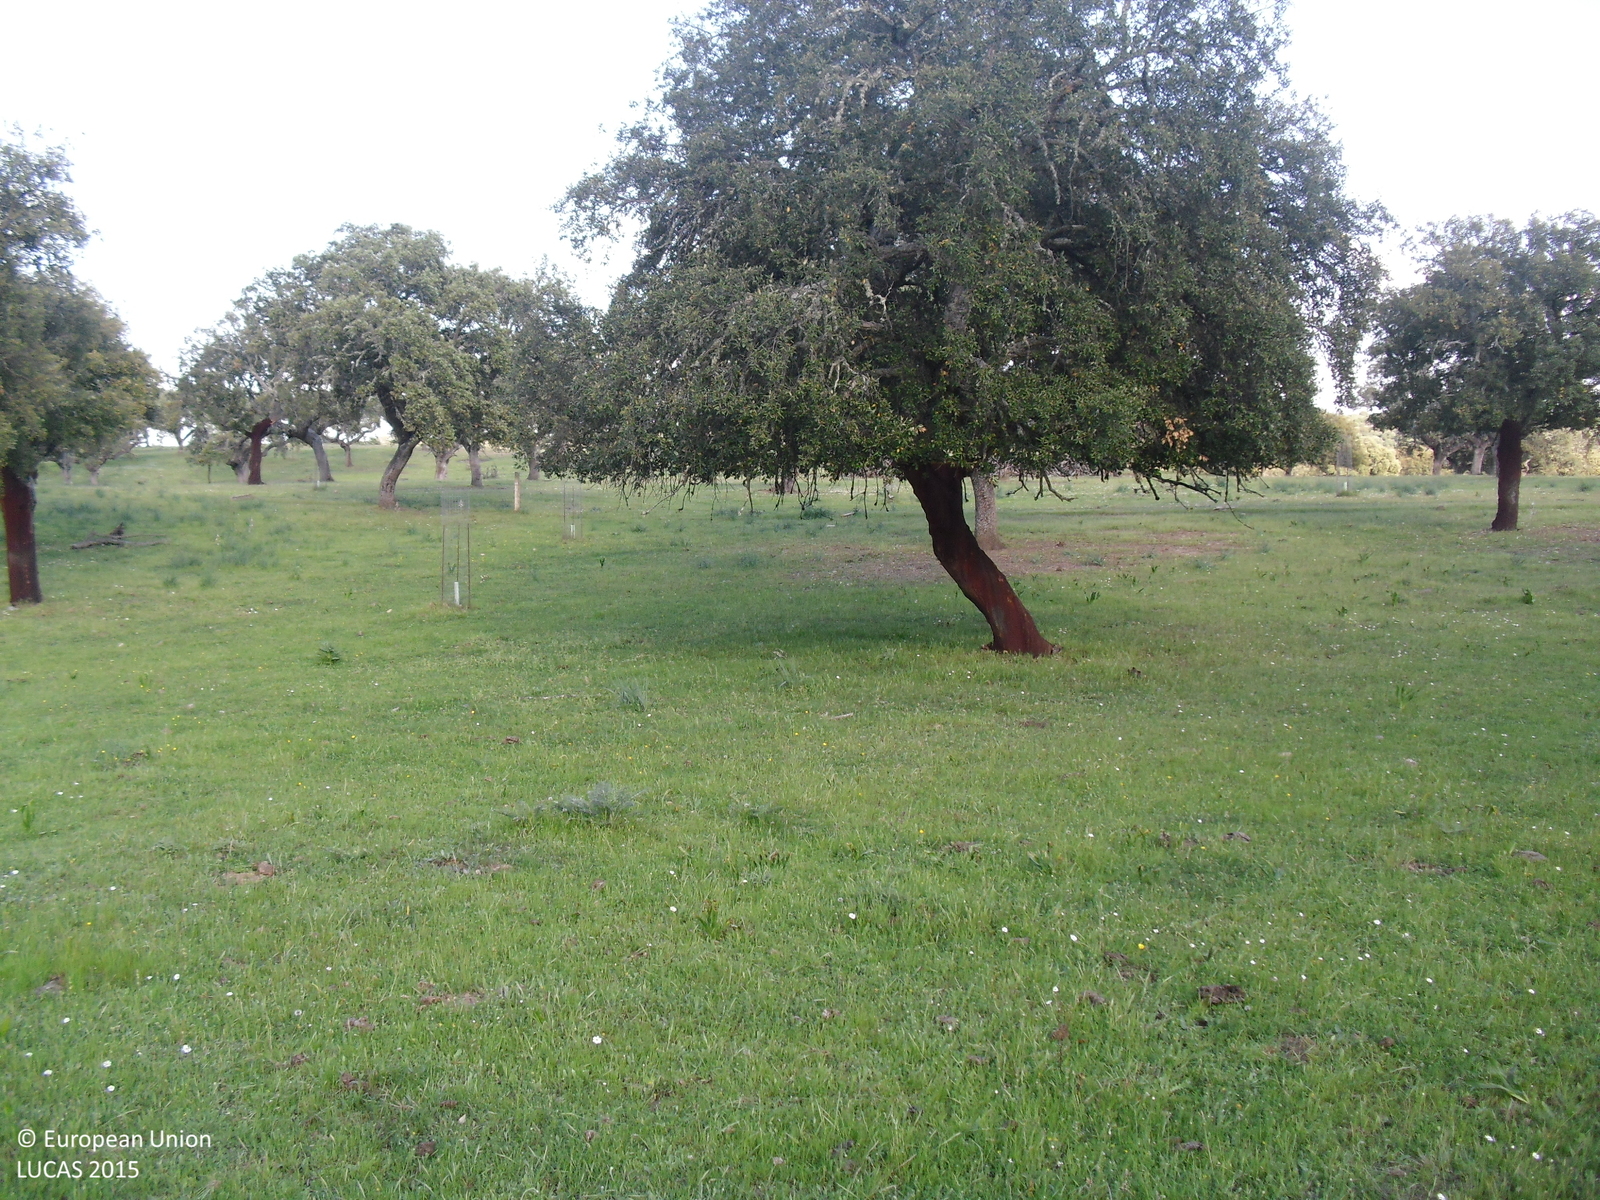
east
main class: Woodland
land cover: Broadleaved woodland
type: broadleaved evergreen forest
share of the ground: > 75 %
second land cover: Grassland without tree/shrub cover
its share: > 75 %
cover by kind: herbaceous plants 85 %, broadleaved forest trees 15 %
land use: Forestry
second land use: Agriculture (excluding fallow land and kitchen gardens)
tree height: > 5 m
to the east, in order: Broadleaved woodland; Grassland without tree/shrub cover; Broadleaved woodland; Fences; Broadleaved woodland; Tracks; Broadleaved woodland
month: April
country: ES
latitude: 39.3821
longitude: -6.5673
